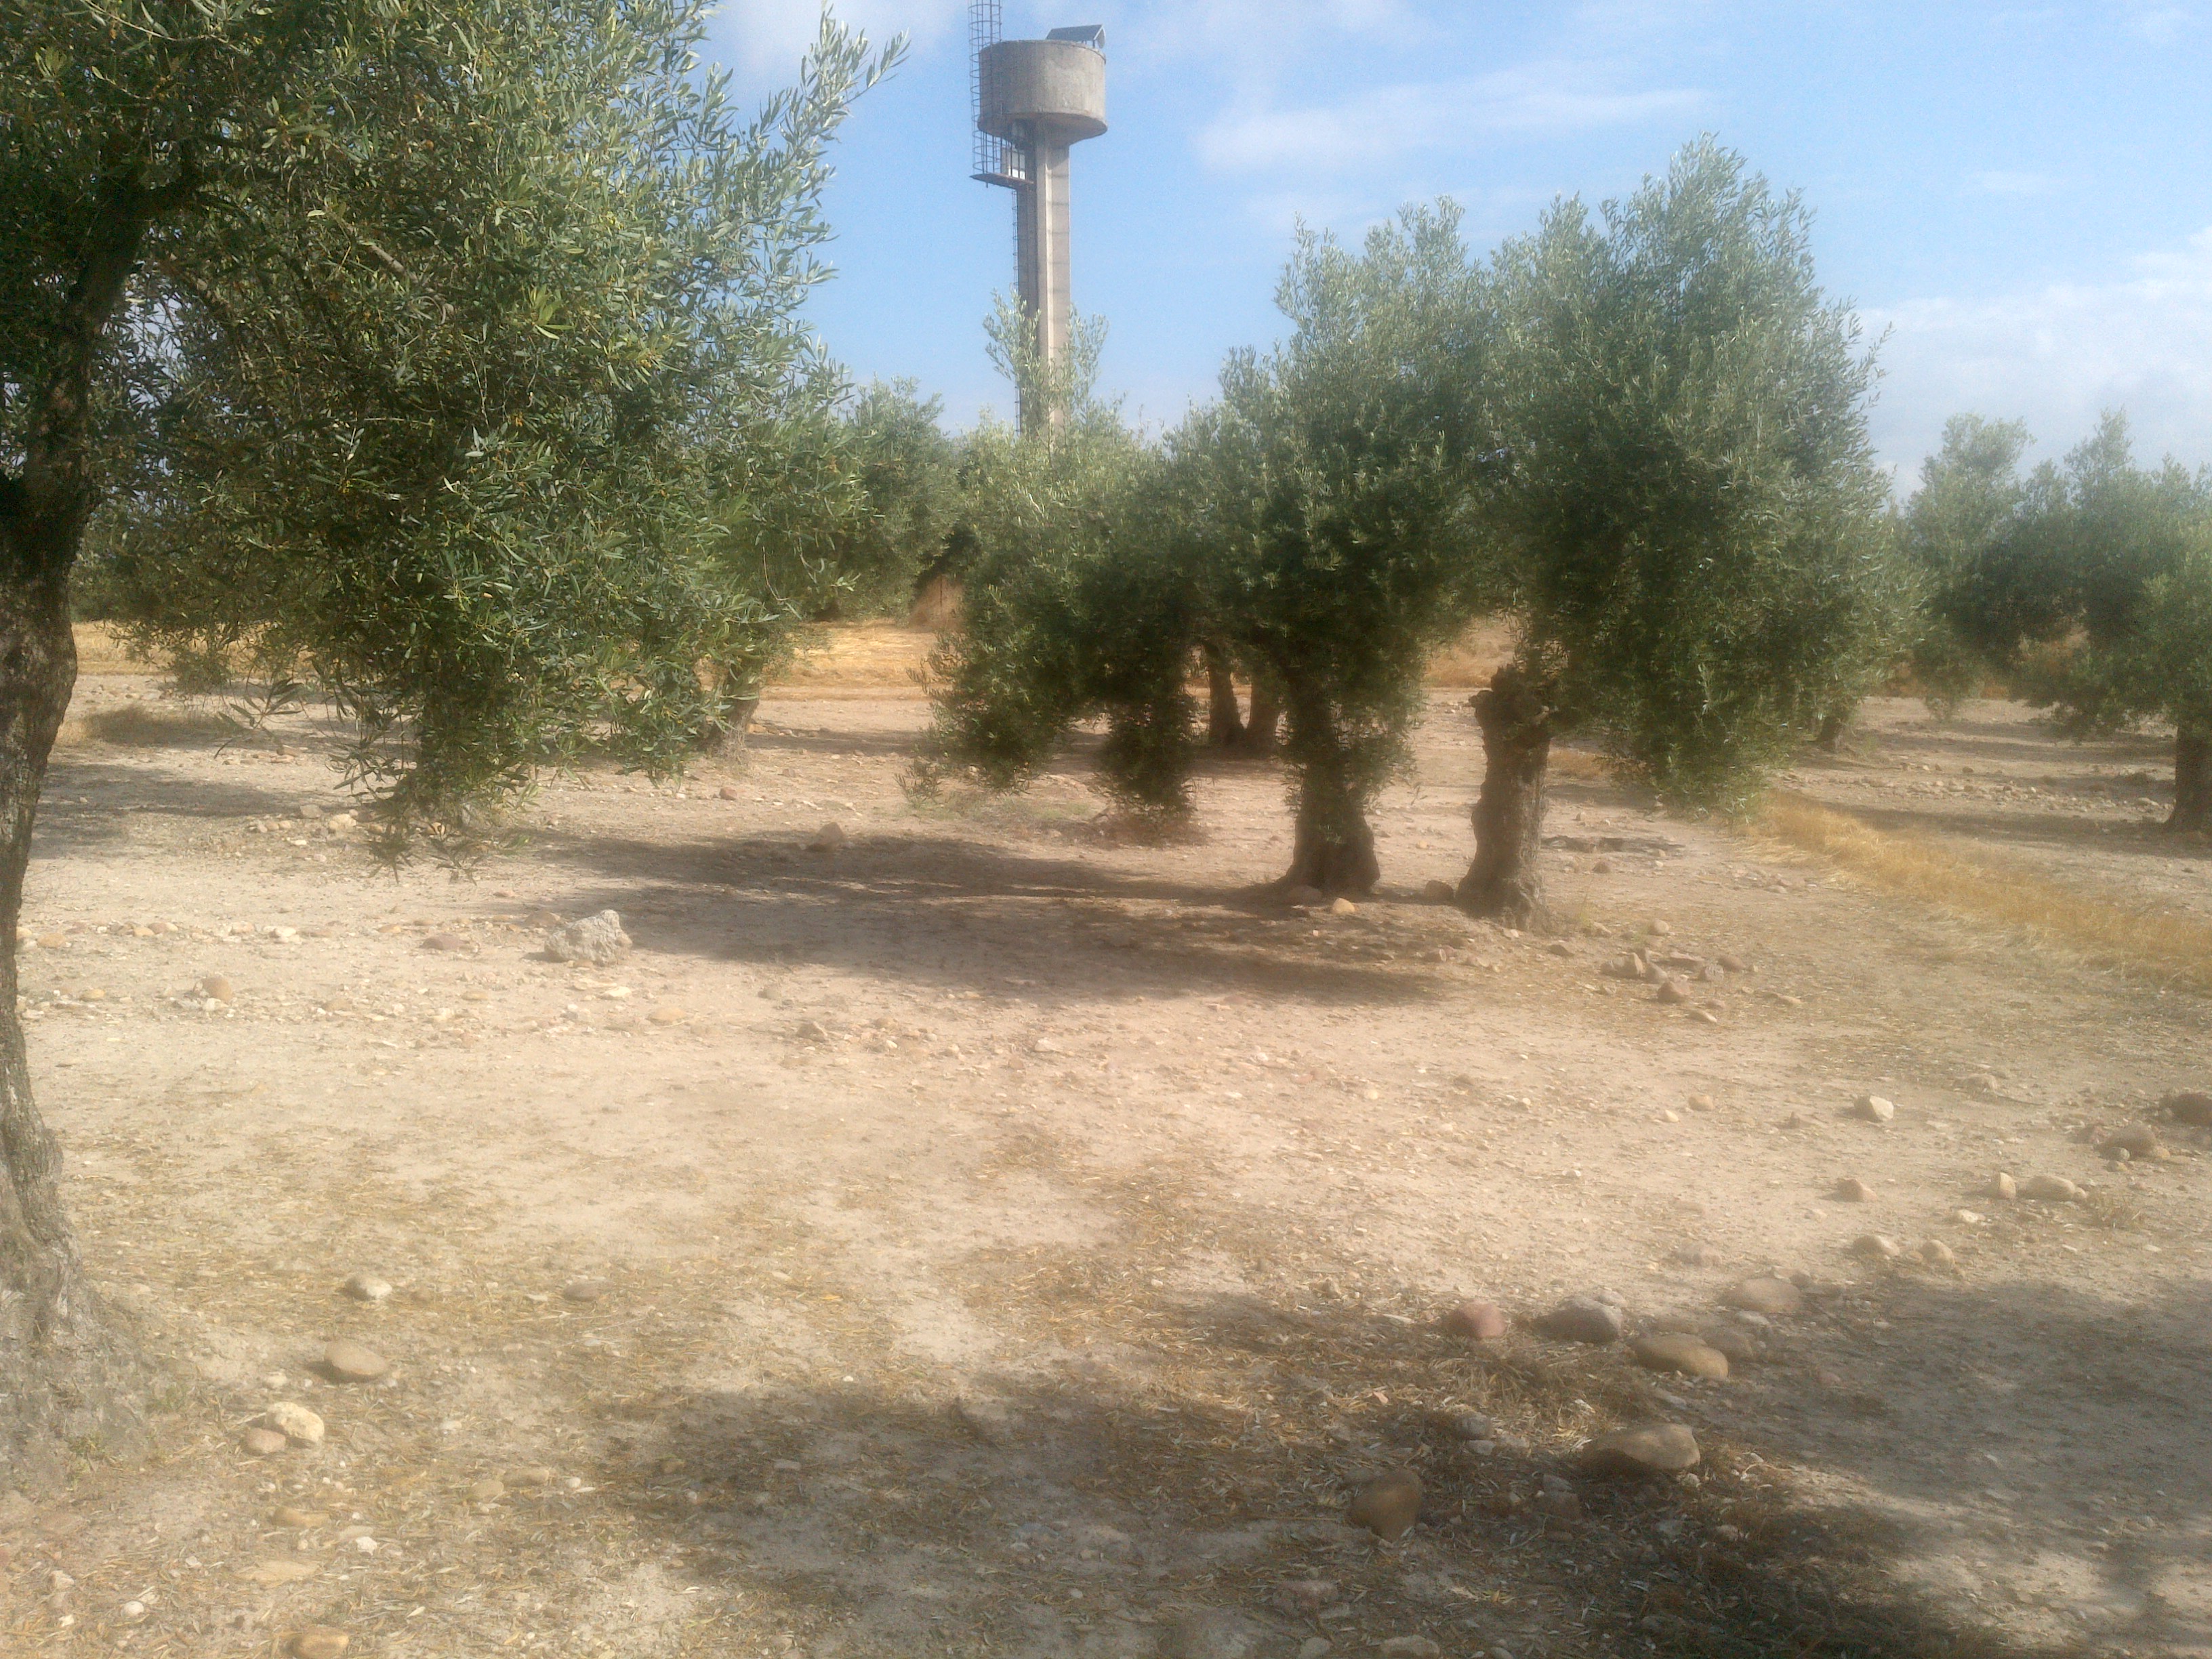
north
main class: Cropland
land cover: Olive groves
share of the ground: 25 - 50 %
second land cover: Spontaneously vegetated surfaces
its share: 10 - 25 %
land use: Agriculture (excluding fallow land and kitchen gardens)
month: June
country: ES
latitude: 37.9323
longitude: -4.5180
